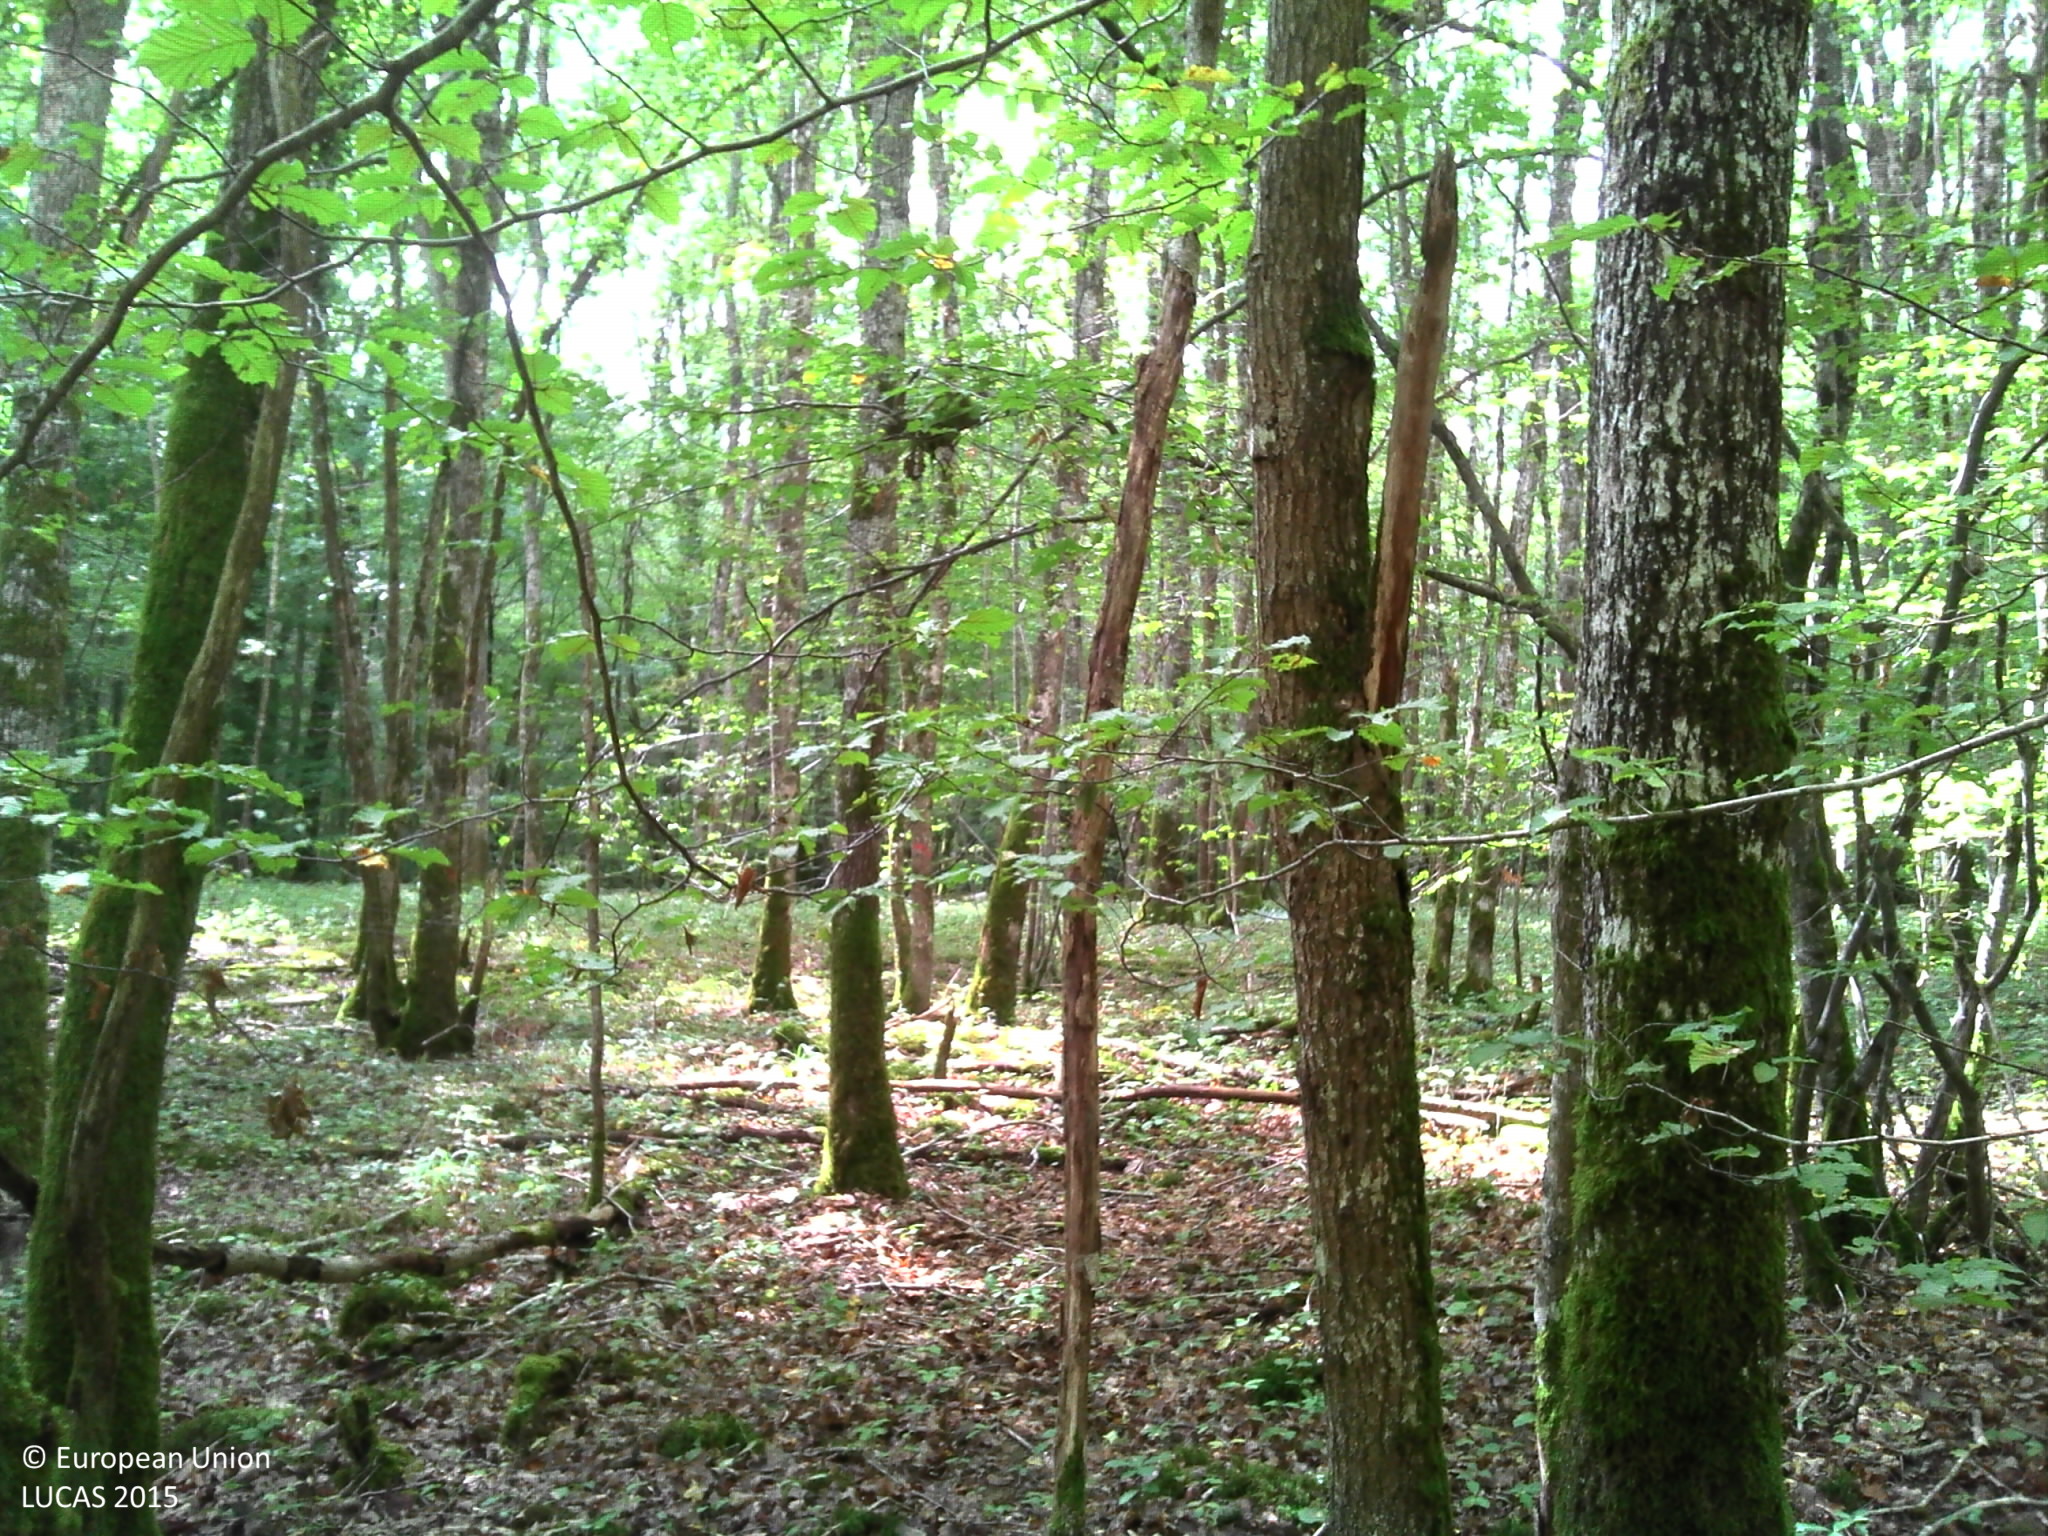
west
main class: Woodland
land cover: Broadleaved woodland
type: mesophytic deciduous forest
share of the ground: > 75 %
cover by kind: broadleaved forest trees 90 %, unconsolidated bare surface 10 %
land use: Forestry
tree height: > 5 m
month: July
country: FR
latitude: 46.8287
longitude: 3.6141
